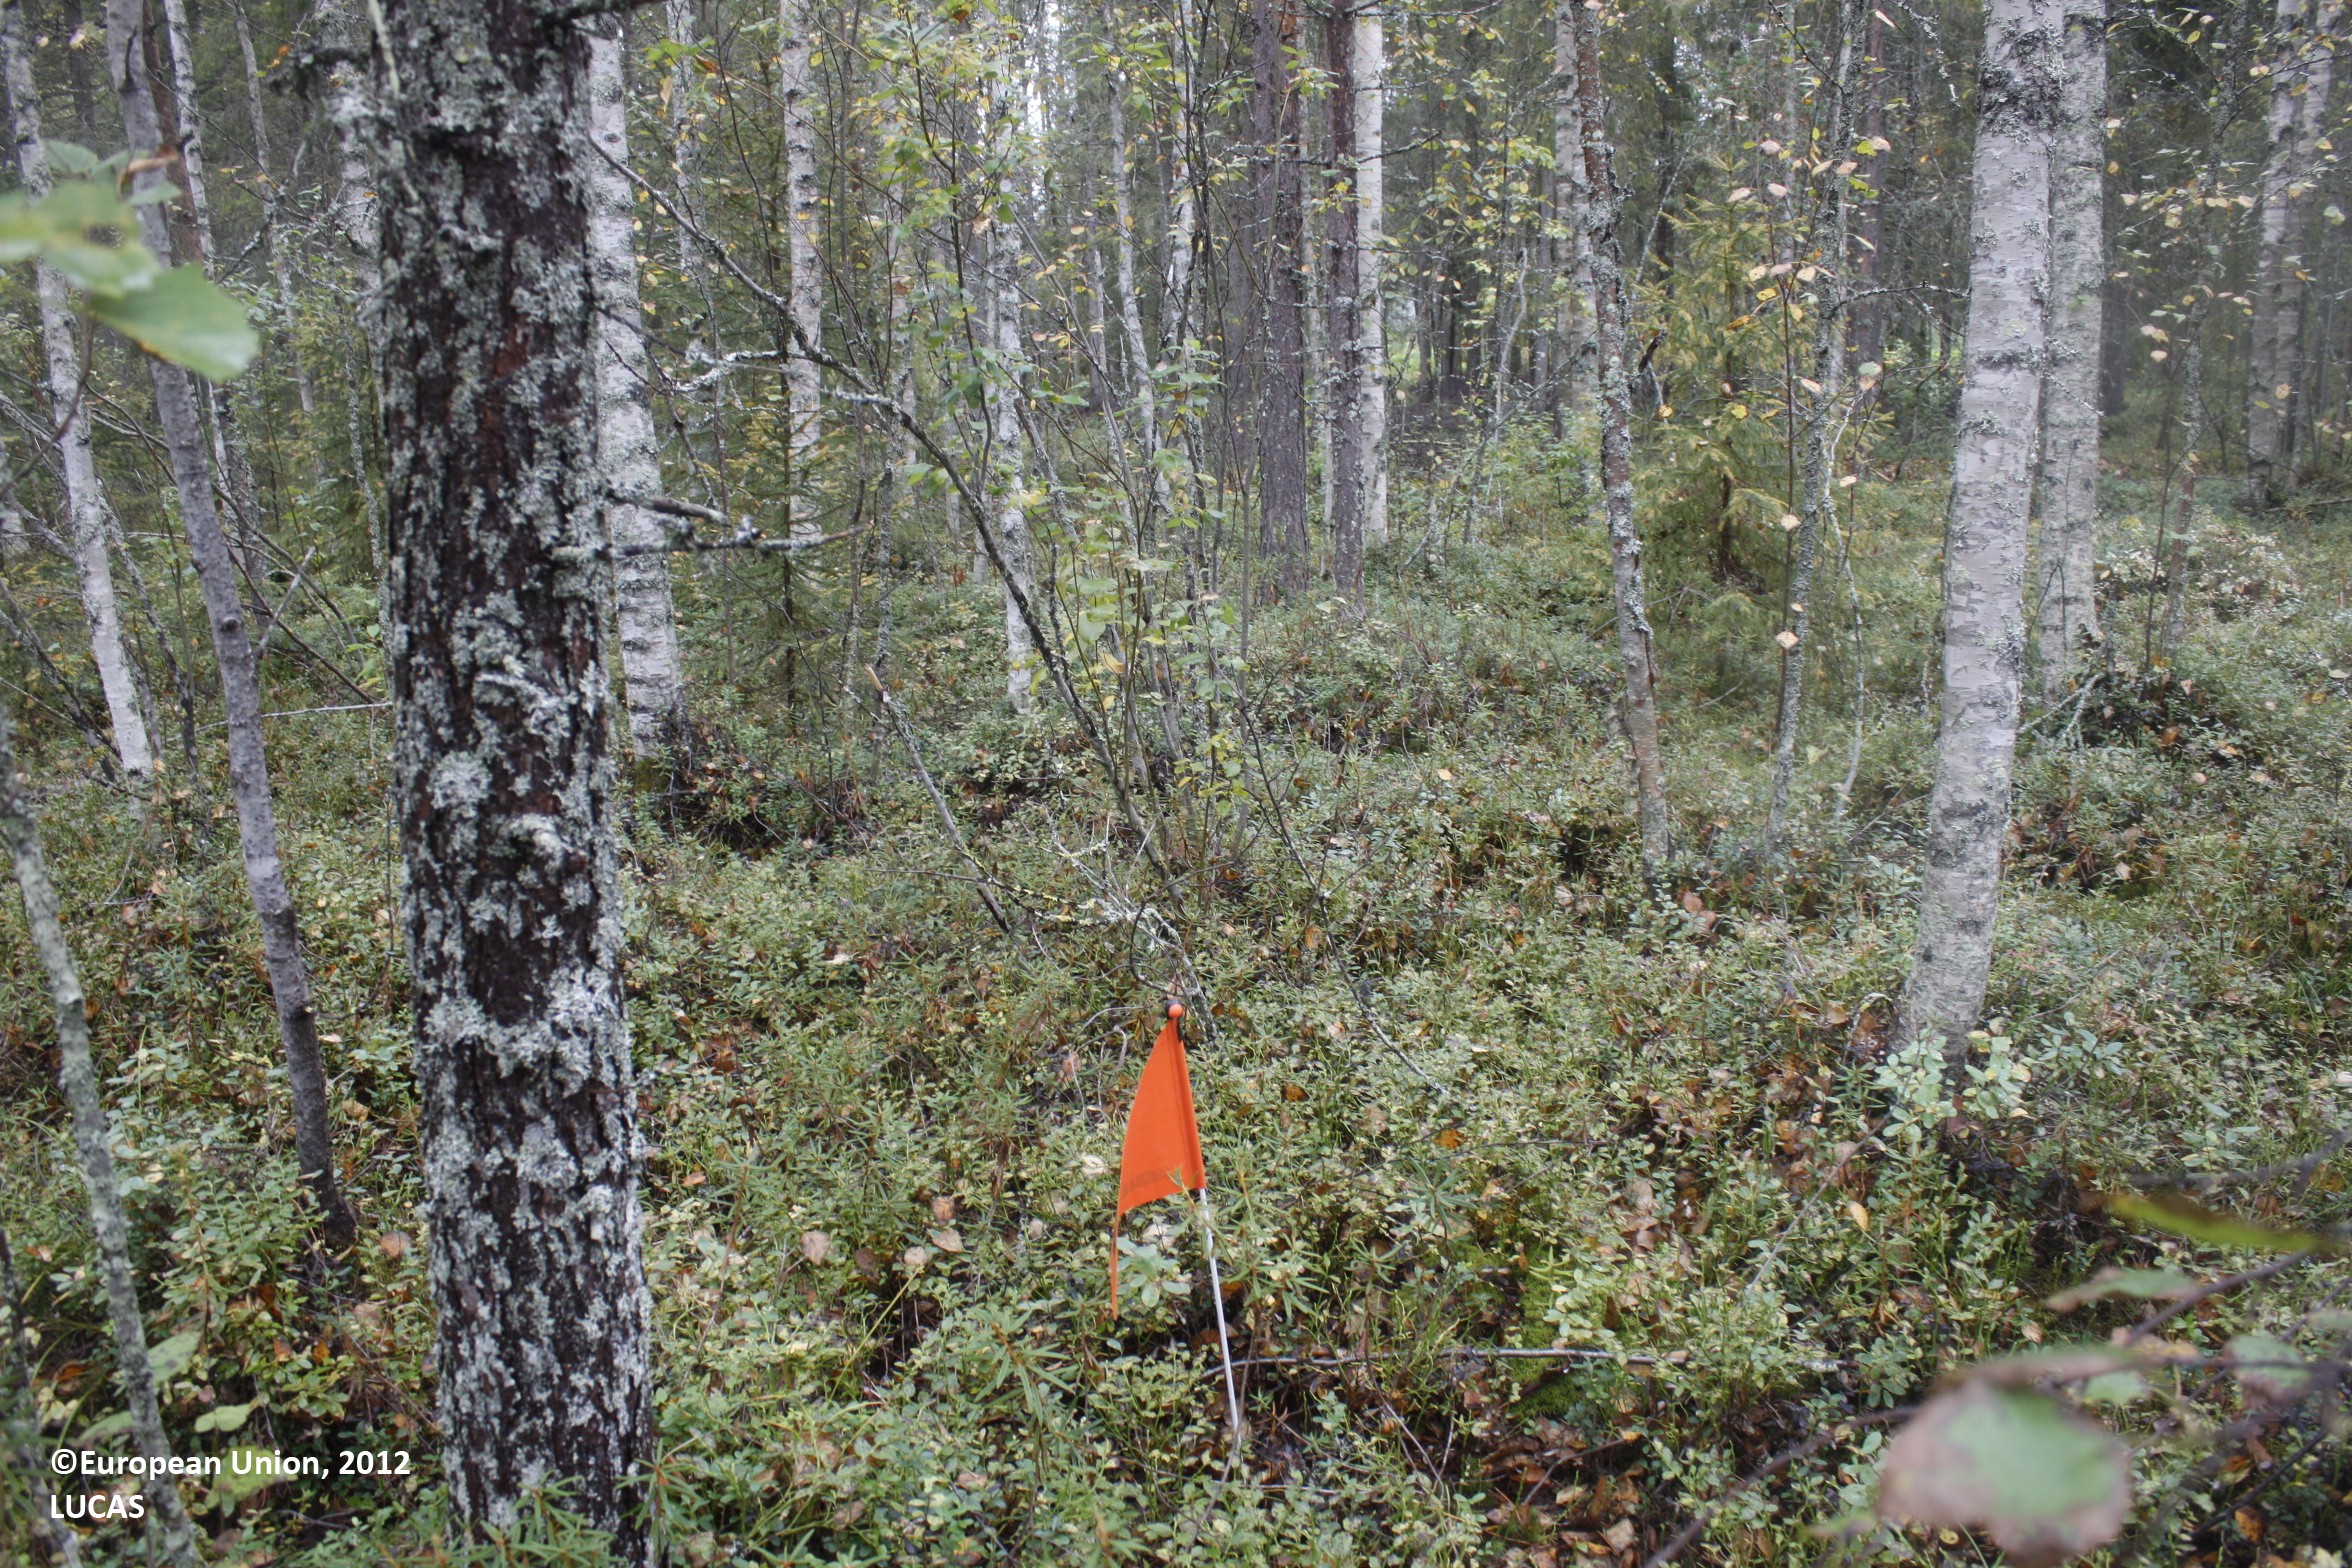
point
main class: Woodland
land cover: Other mixed woodland
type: boreal forest
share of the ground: 50 - 75 %
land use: Forestry
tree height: > 5 m
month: September
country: FI
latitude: 65.1398
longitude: 26.6750
